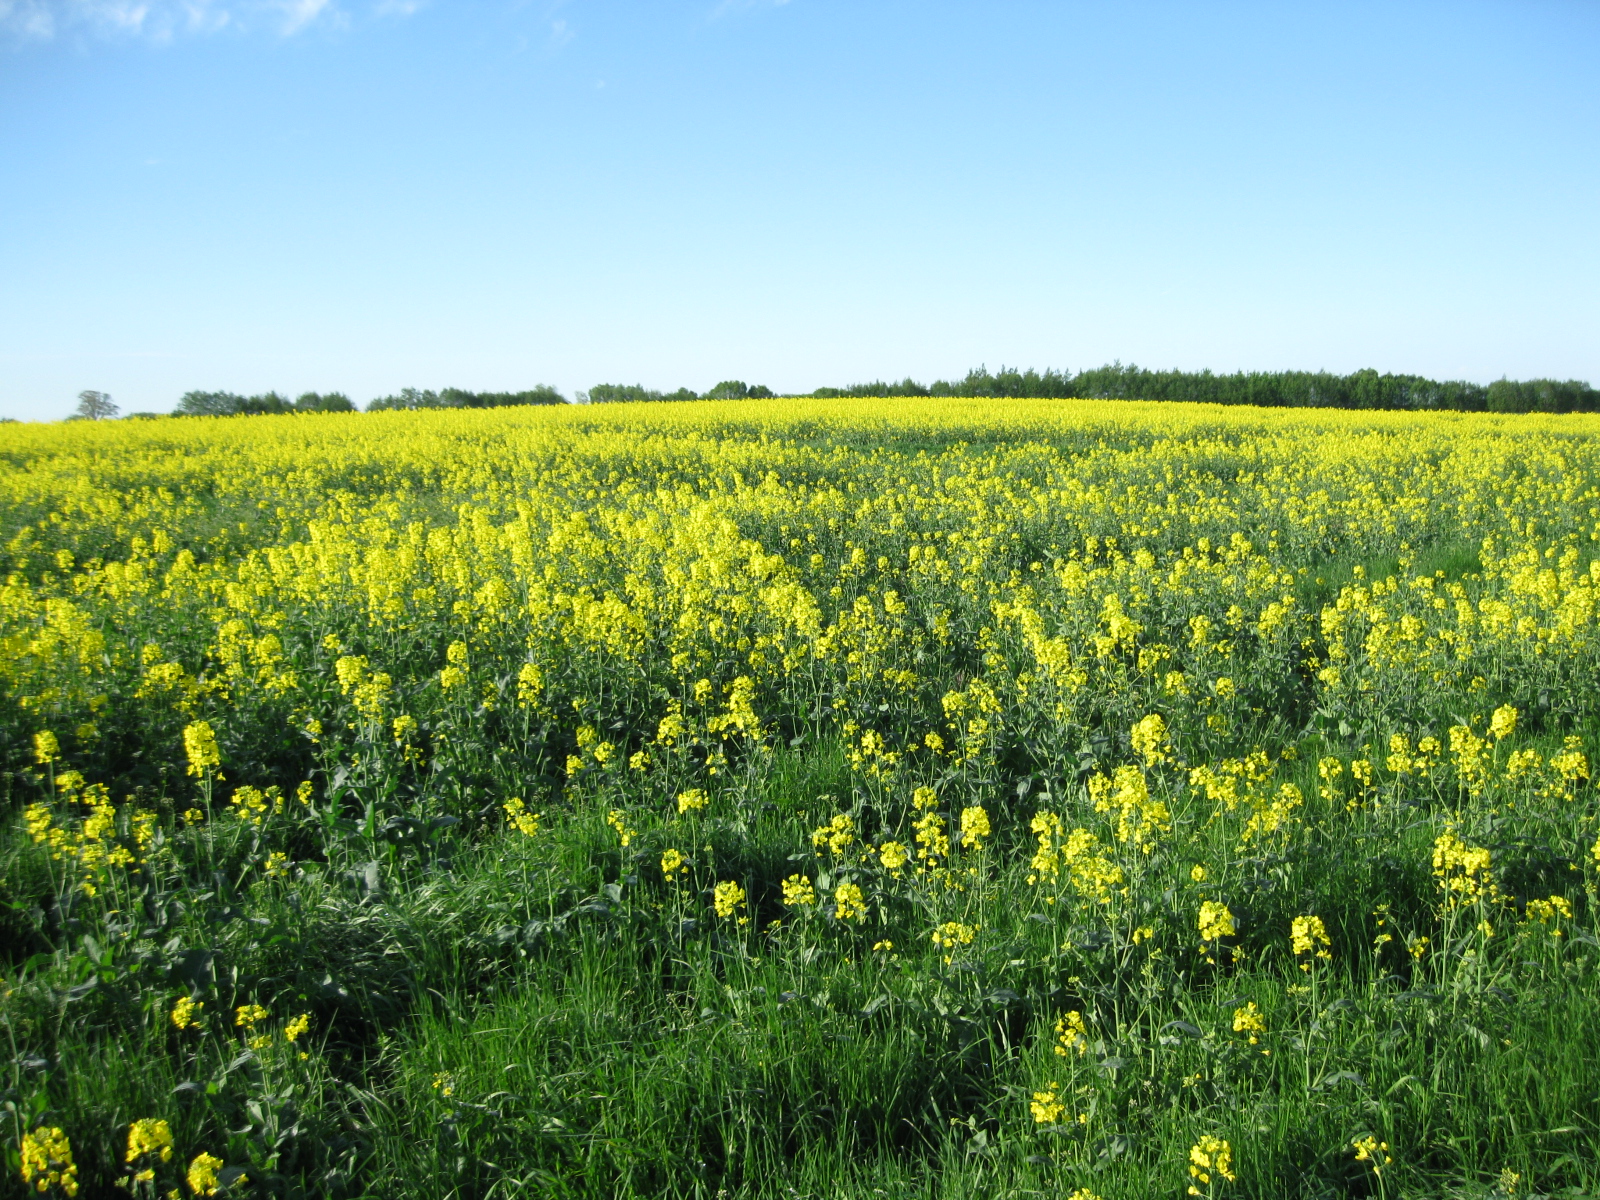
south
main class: Cropland
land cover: Rape and turnip rape
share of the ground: > 75 %
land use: Agriculture (excluding fallow land and kitchen gardens)
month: May
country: LT
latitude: 56.1839
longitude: 23.9905
